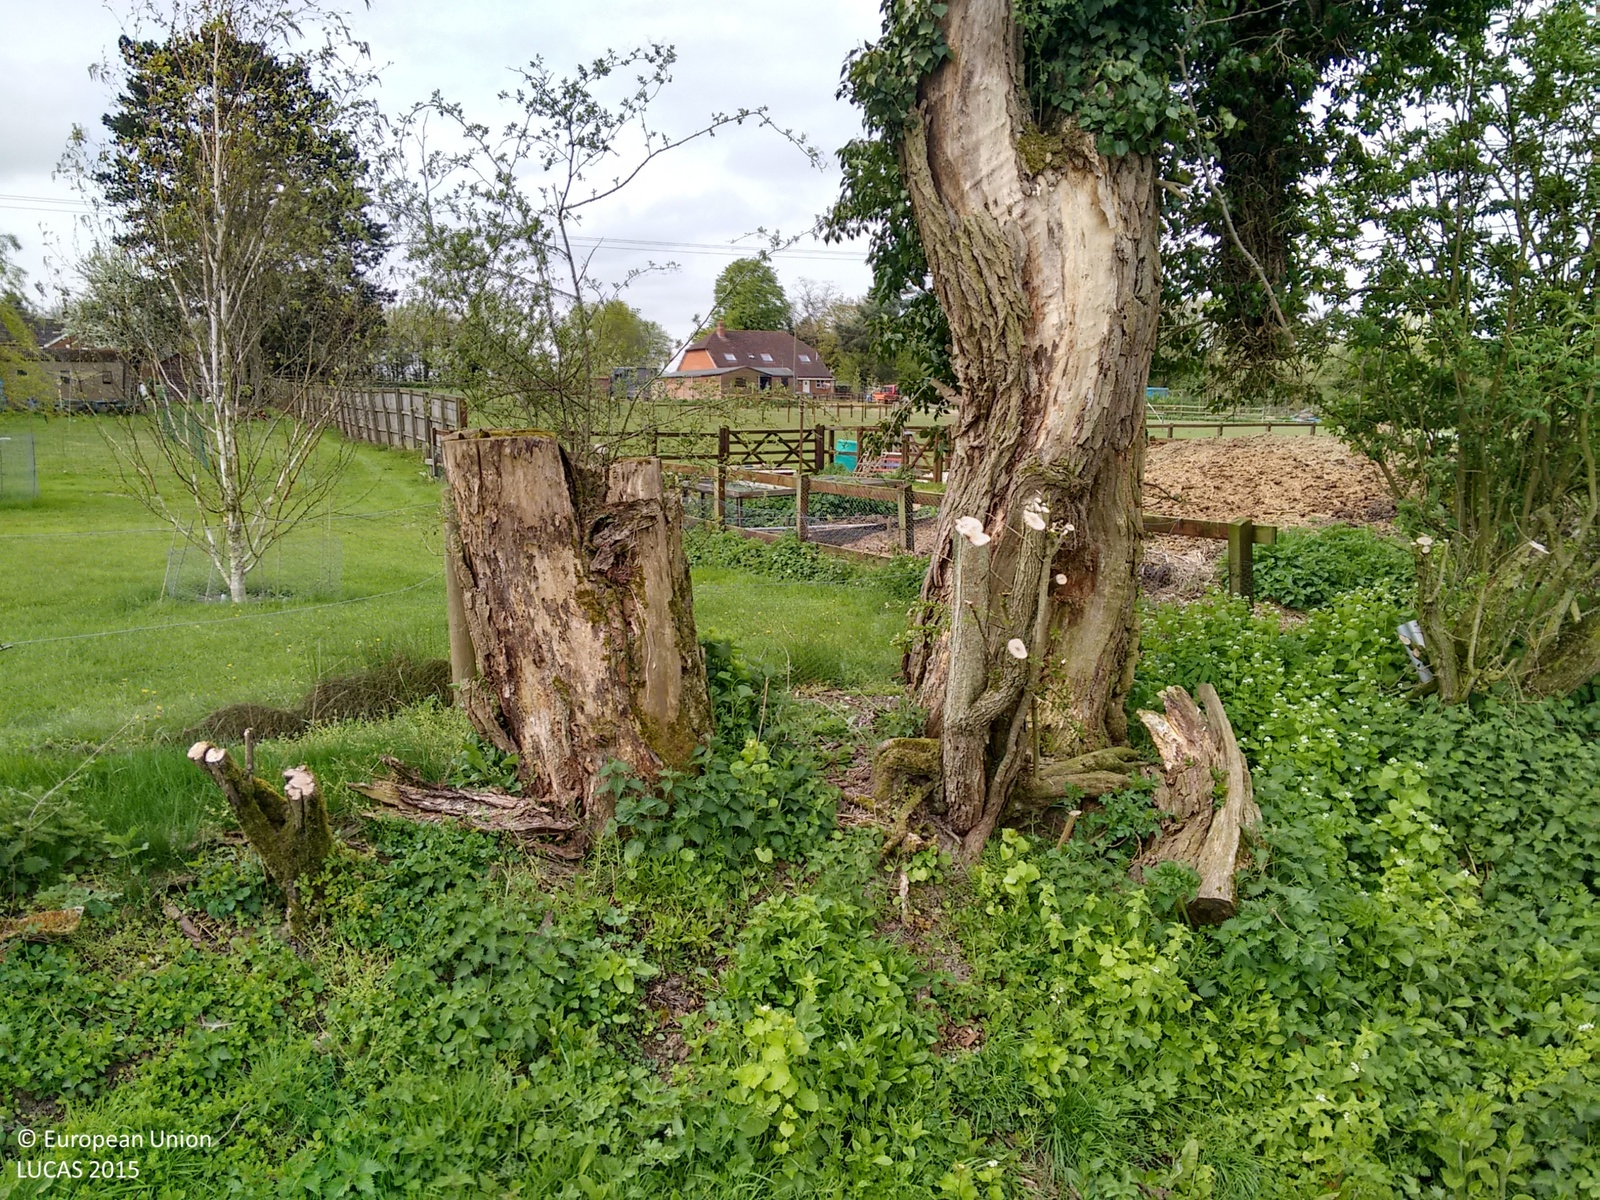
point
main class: Grassland
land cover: Grassland without tree/shrub cover
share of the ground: > 75 %
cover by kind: herbaceous plants 100 %
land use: Residential
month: May
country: GB
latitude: 51.1433
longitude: -0.9500
